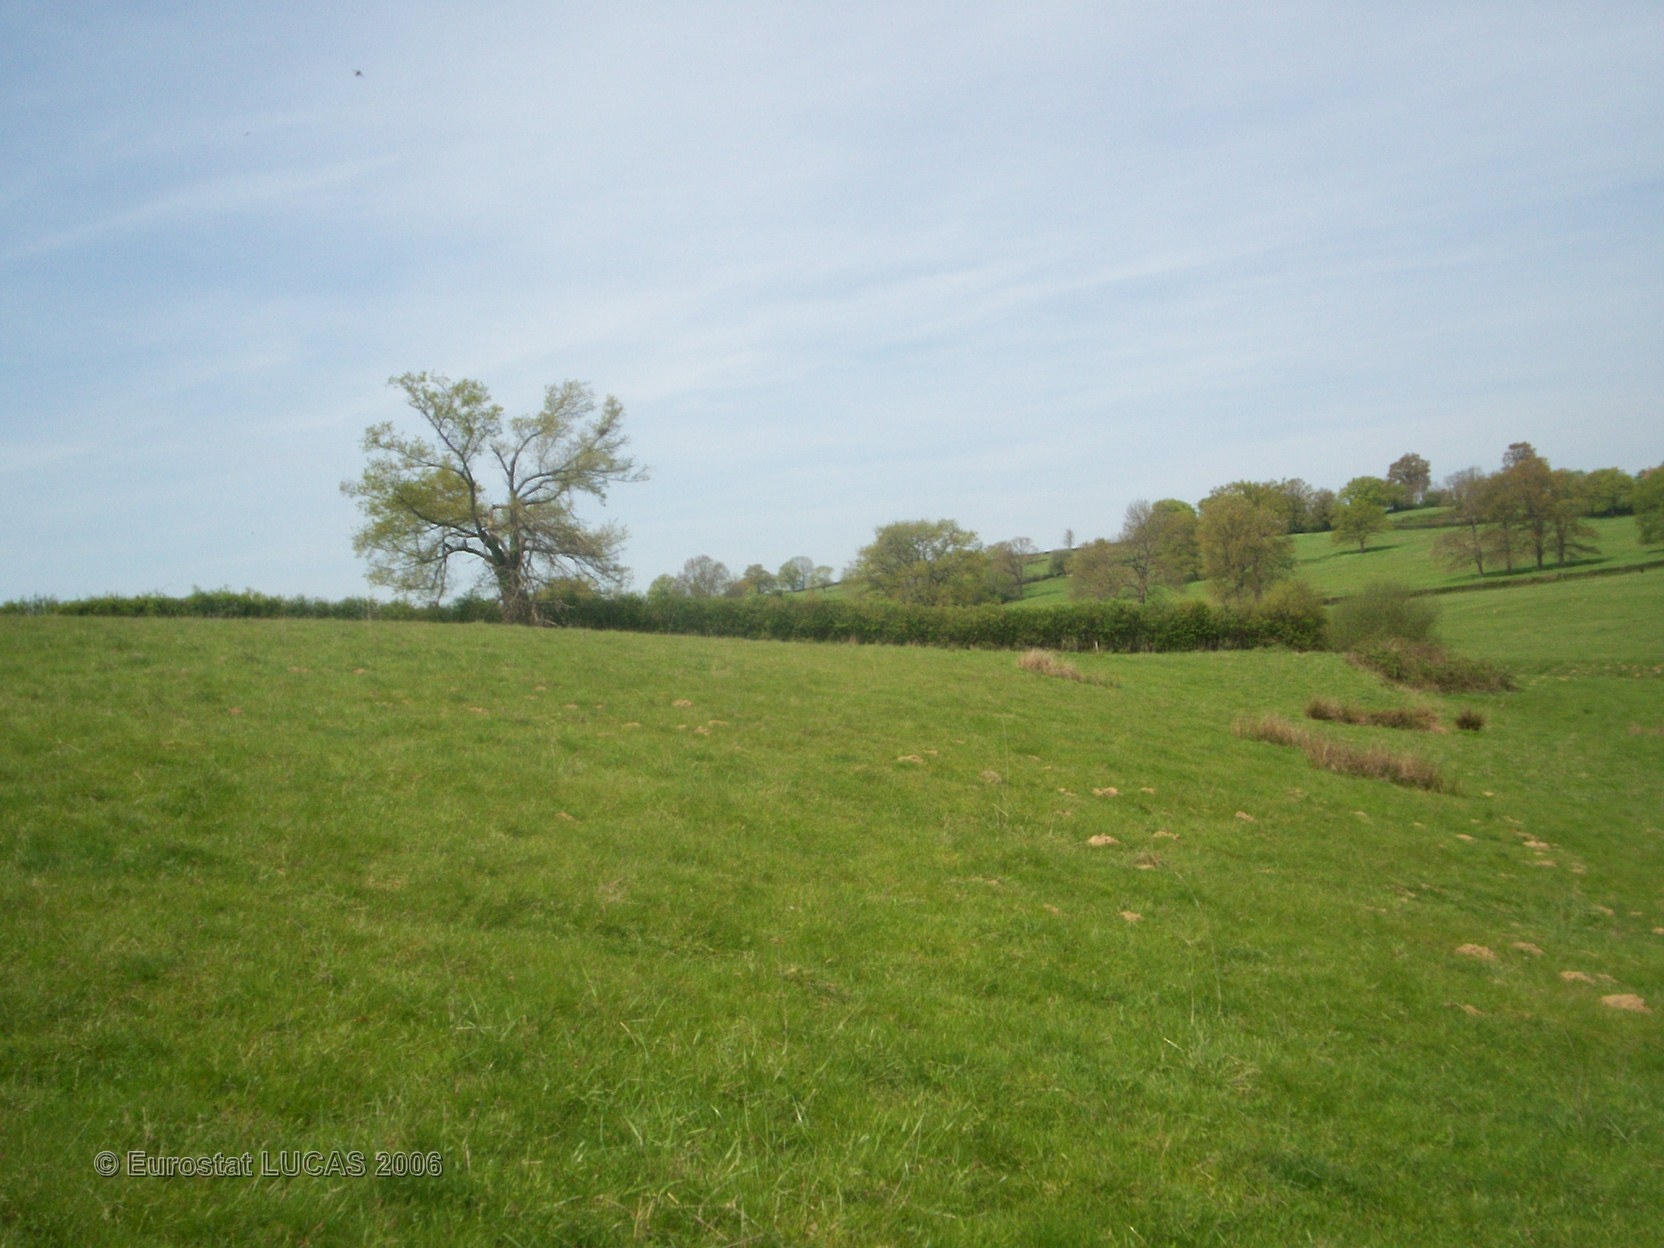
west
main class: Grassland
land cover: Grassland without tree/shrub cover
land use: Agriculture (excluding fallow land and kitchen gardens)
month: May
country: FR
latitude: 46.5064
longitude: 3.0775
